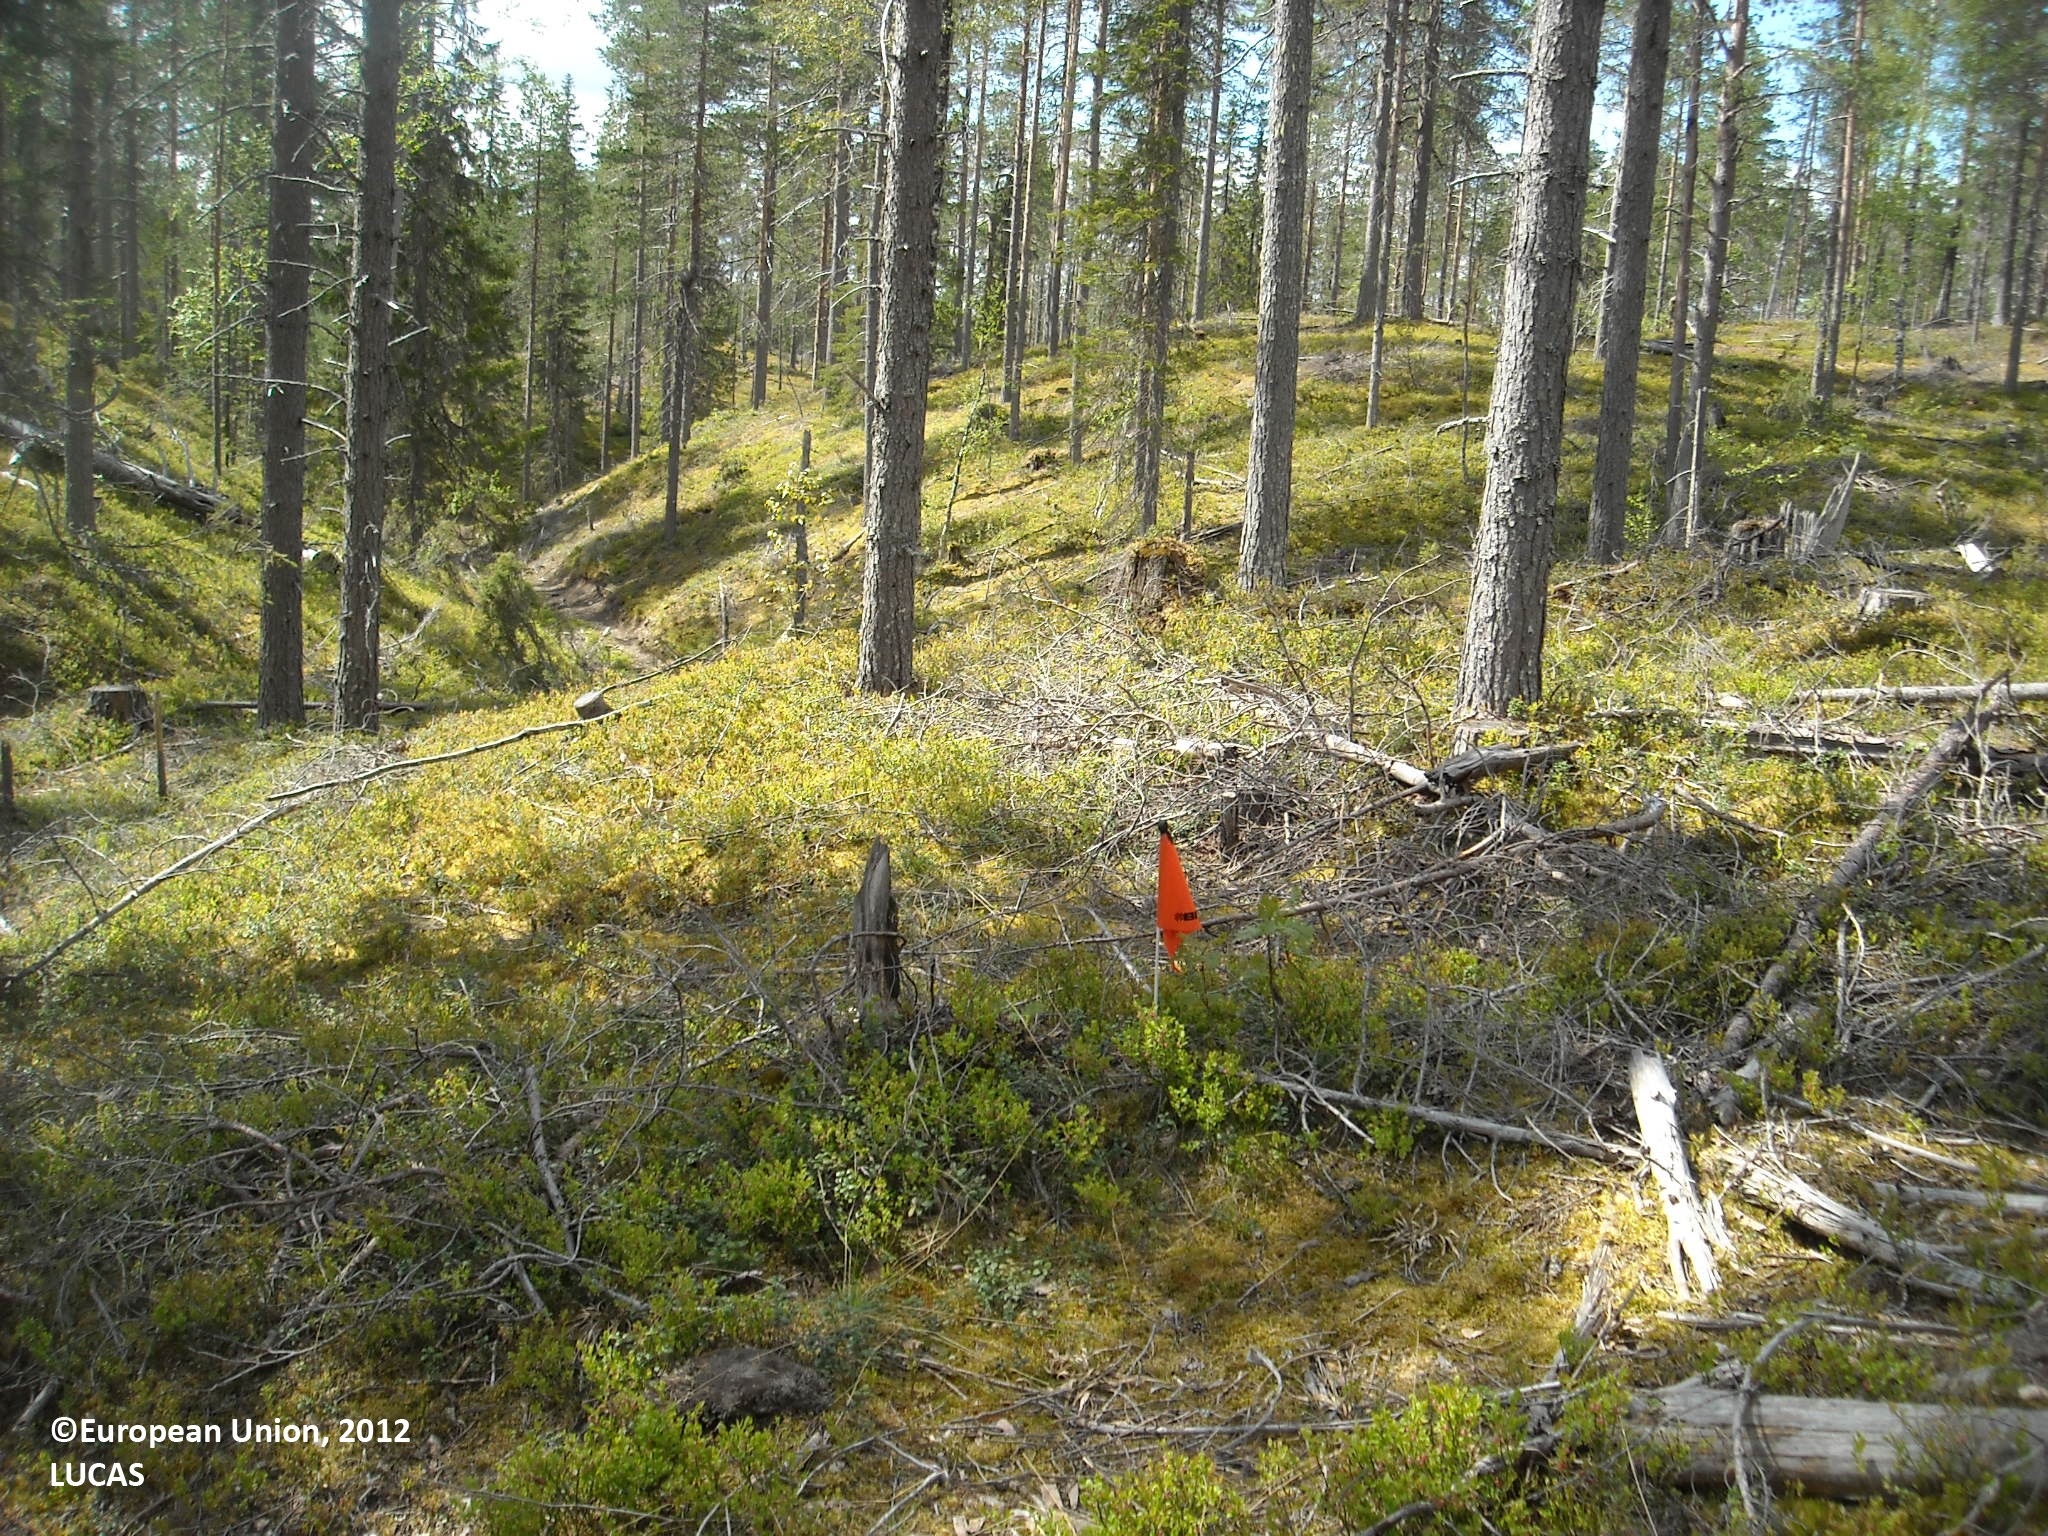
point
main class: Woodland
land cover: Pine dominated coniferous woodland
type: boreal forest
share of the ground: 50 - 75 %
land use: Forestry
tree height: > 5 m
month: June
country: FI
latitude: 65.3513
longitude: 27.8271
